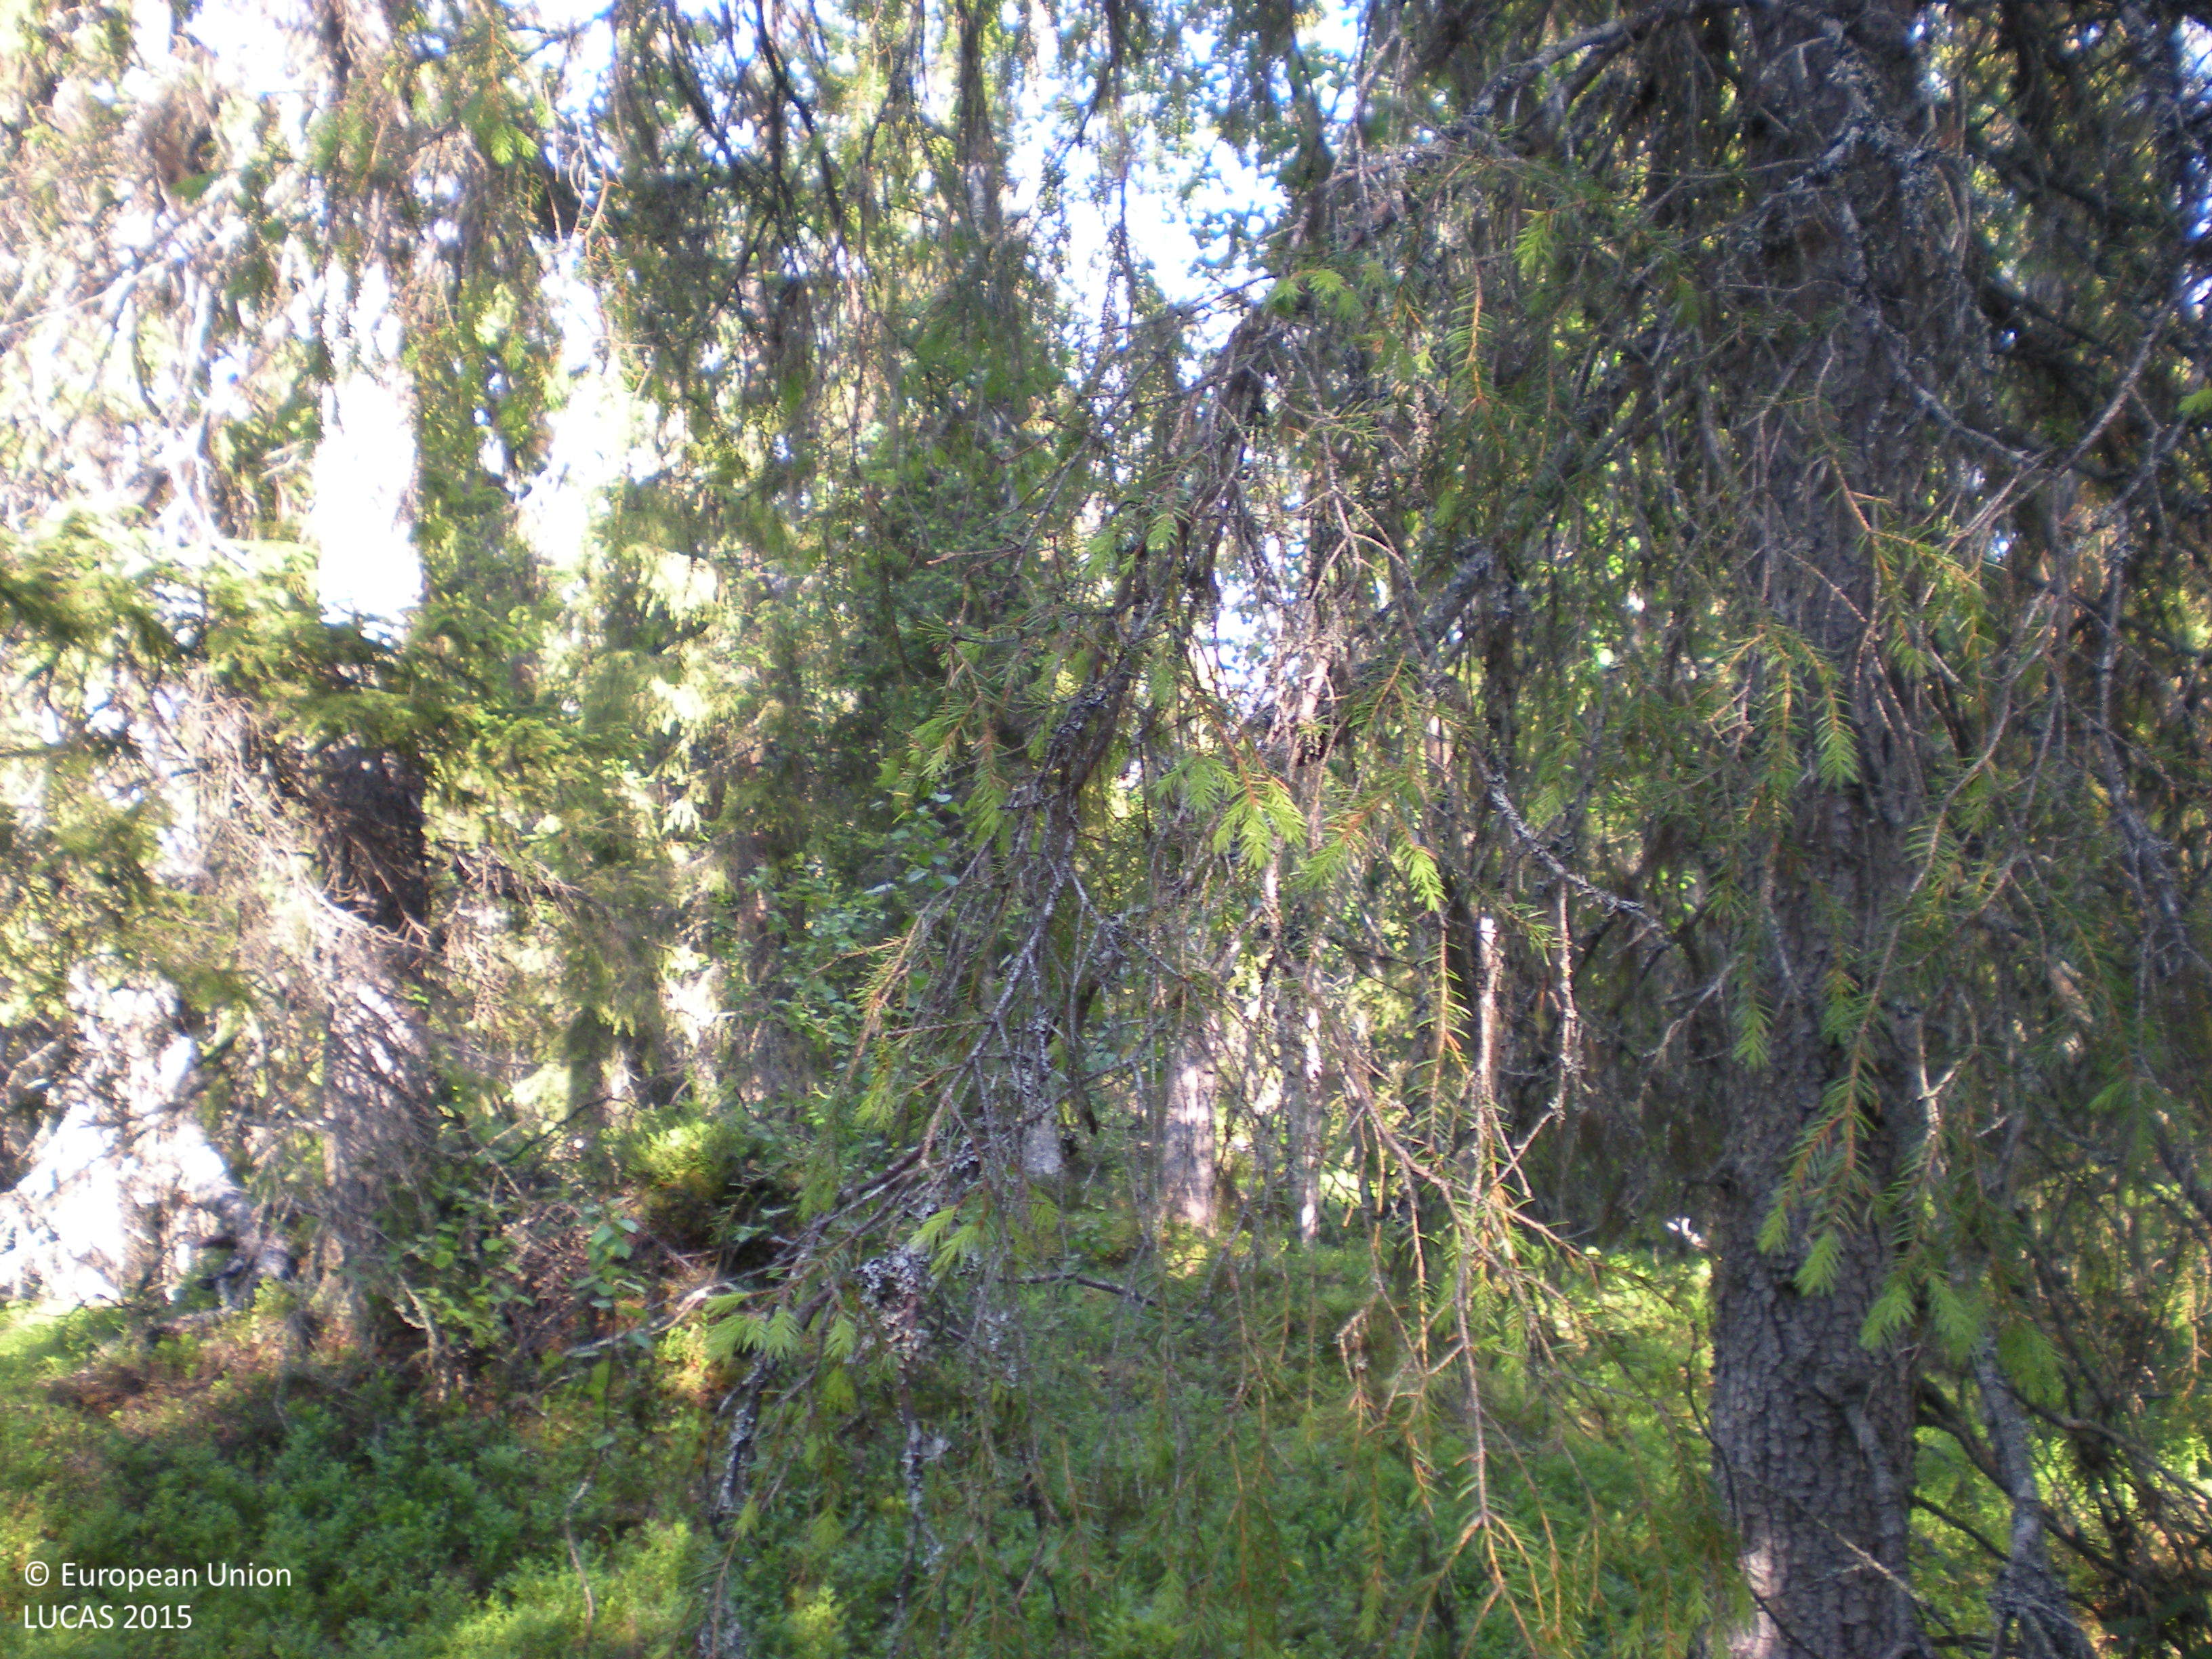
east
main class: Woodland
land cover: Spruce dominated mixed woodland
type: boreal forest
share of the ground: > 75 %
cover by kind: coniferous forest trees 50 %, broadleaved forest trees 25 %, shrubs 20 %, lichens and mosses 5 %
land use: Forestry
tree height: > 5 m
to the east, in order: Spruce dominated mixed woodland
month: July
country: SE
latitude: 65.6061
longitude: 16.9686
